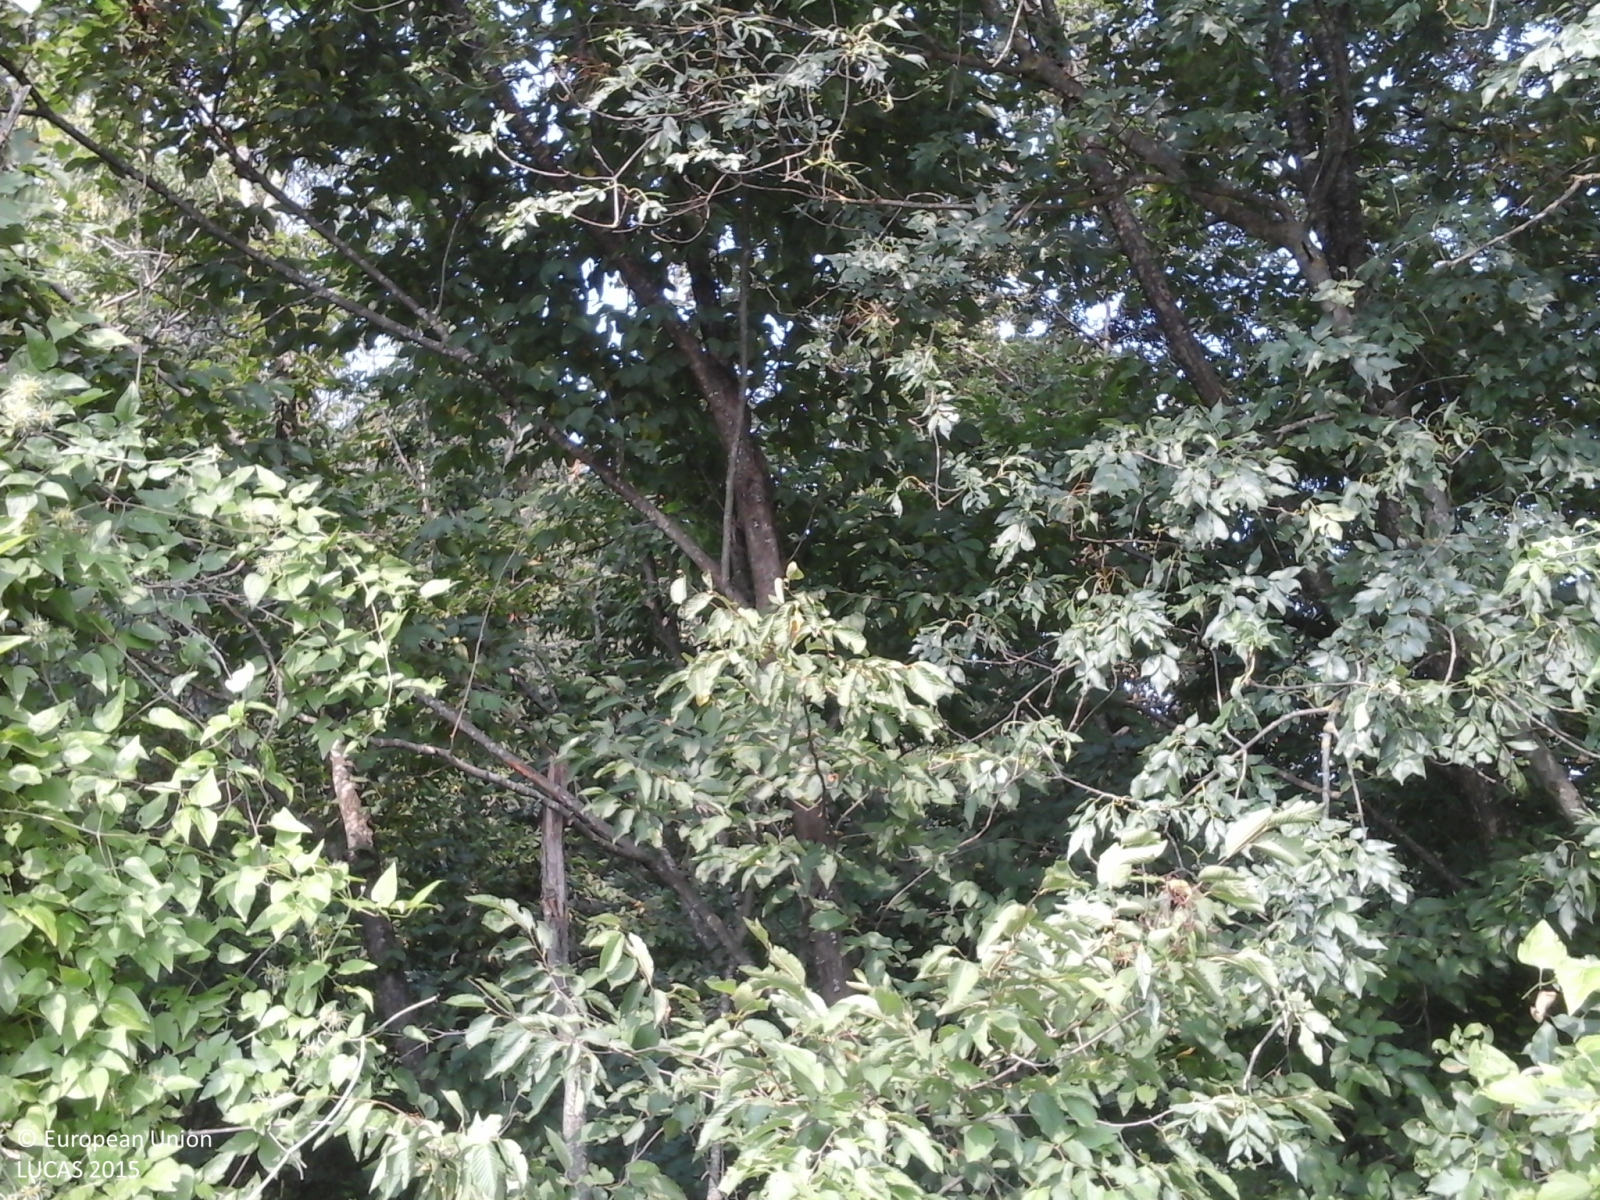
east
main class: Woodland
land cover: Broadleaved woodland
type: thermophilous deciduous forest
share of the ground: 50 - 75 %
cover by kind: broadleaved forest trees 75 %, shrubs 15 %, herbaceous plants 10 %
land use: Forestry
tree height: > 5 m
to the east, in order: Broadleaved woodland
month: July
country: IT
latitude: 44.3669
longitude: 10.5884
